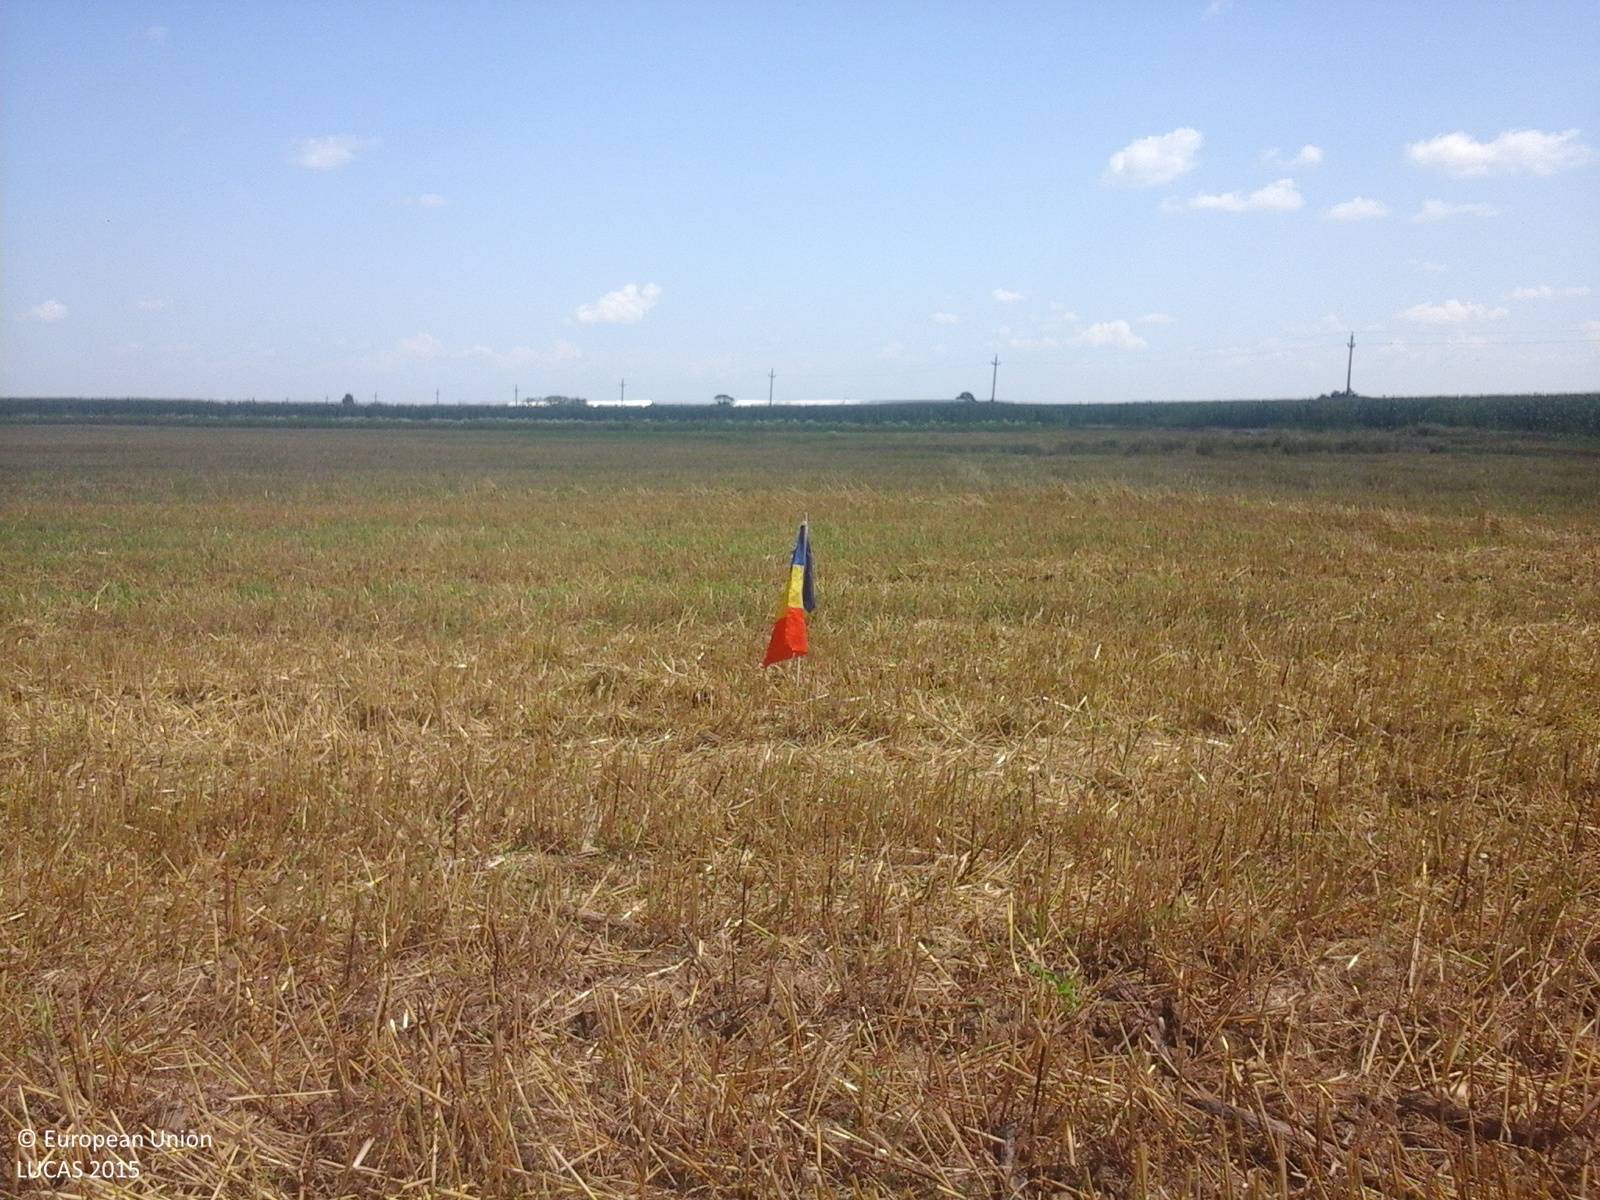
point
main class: Cropland
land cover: Common wheat
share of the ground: 10 - 25 %
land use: Agriculture (excluding fallow land and kitchen gardens)
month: July
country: RO
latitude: 44.3377
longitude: 24.1991
